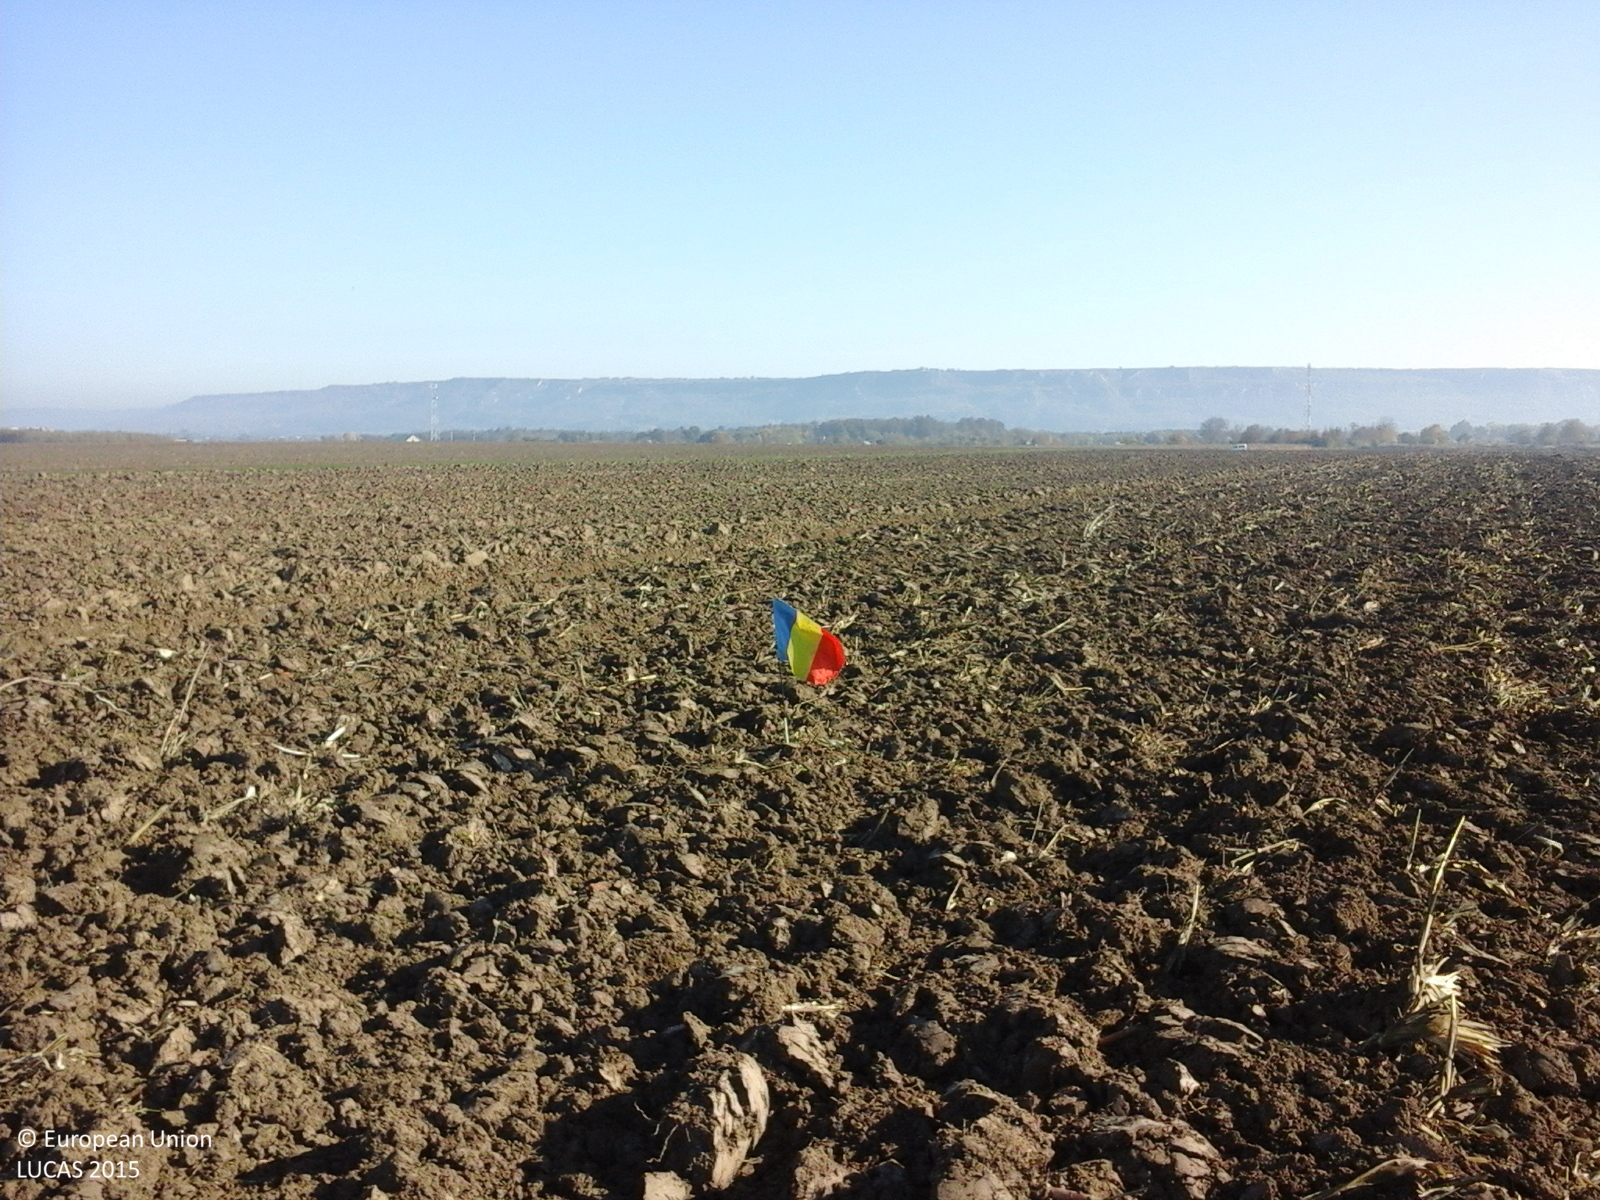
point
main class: Cropland
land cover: Maize
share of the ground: < 10 %
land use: Agriculture (excluding fallow land and kitchen gardens)
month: October
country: RO
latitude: 45.9575
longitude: 27.1931
